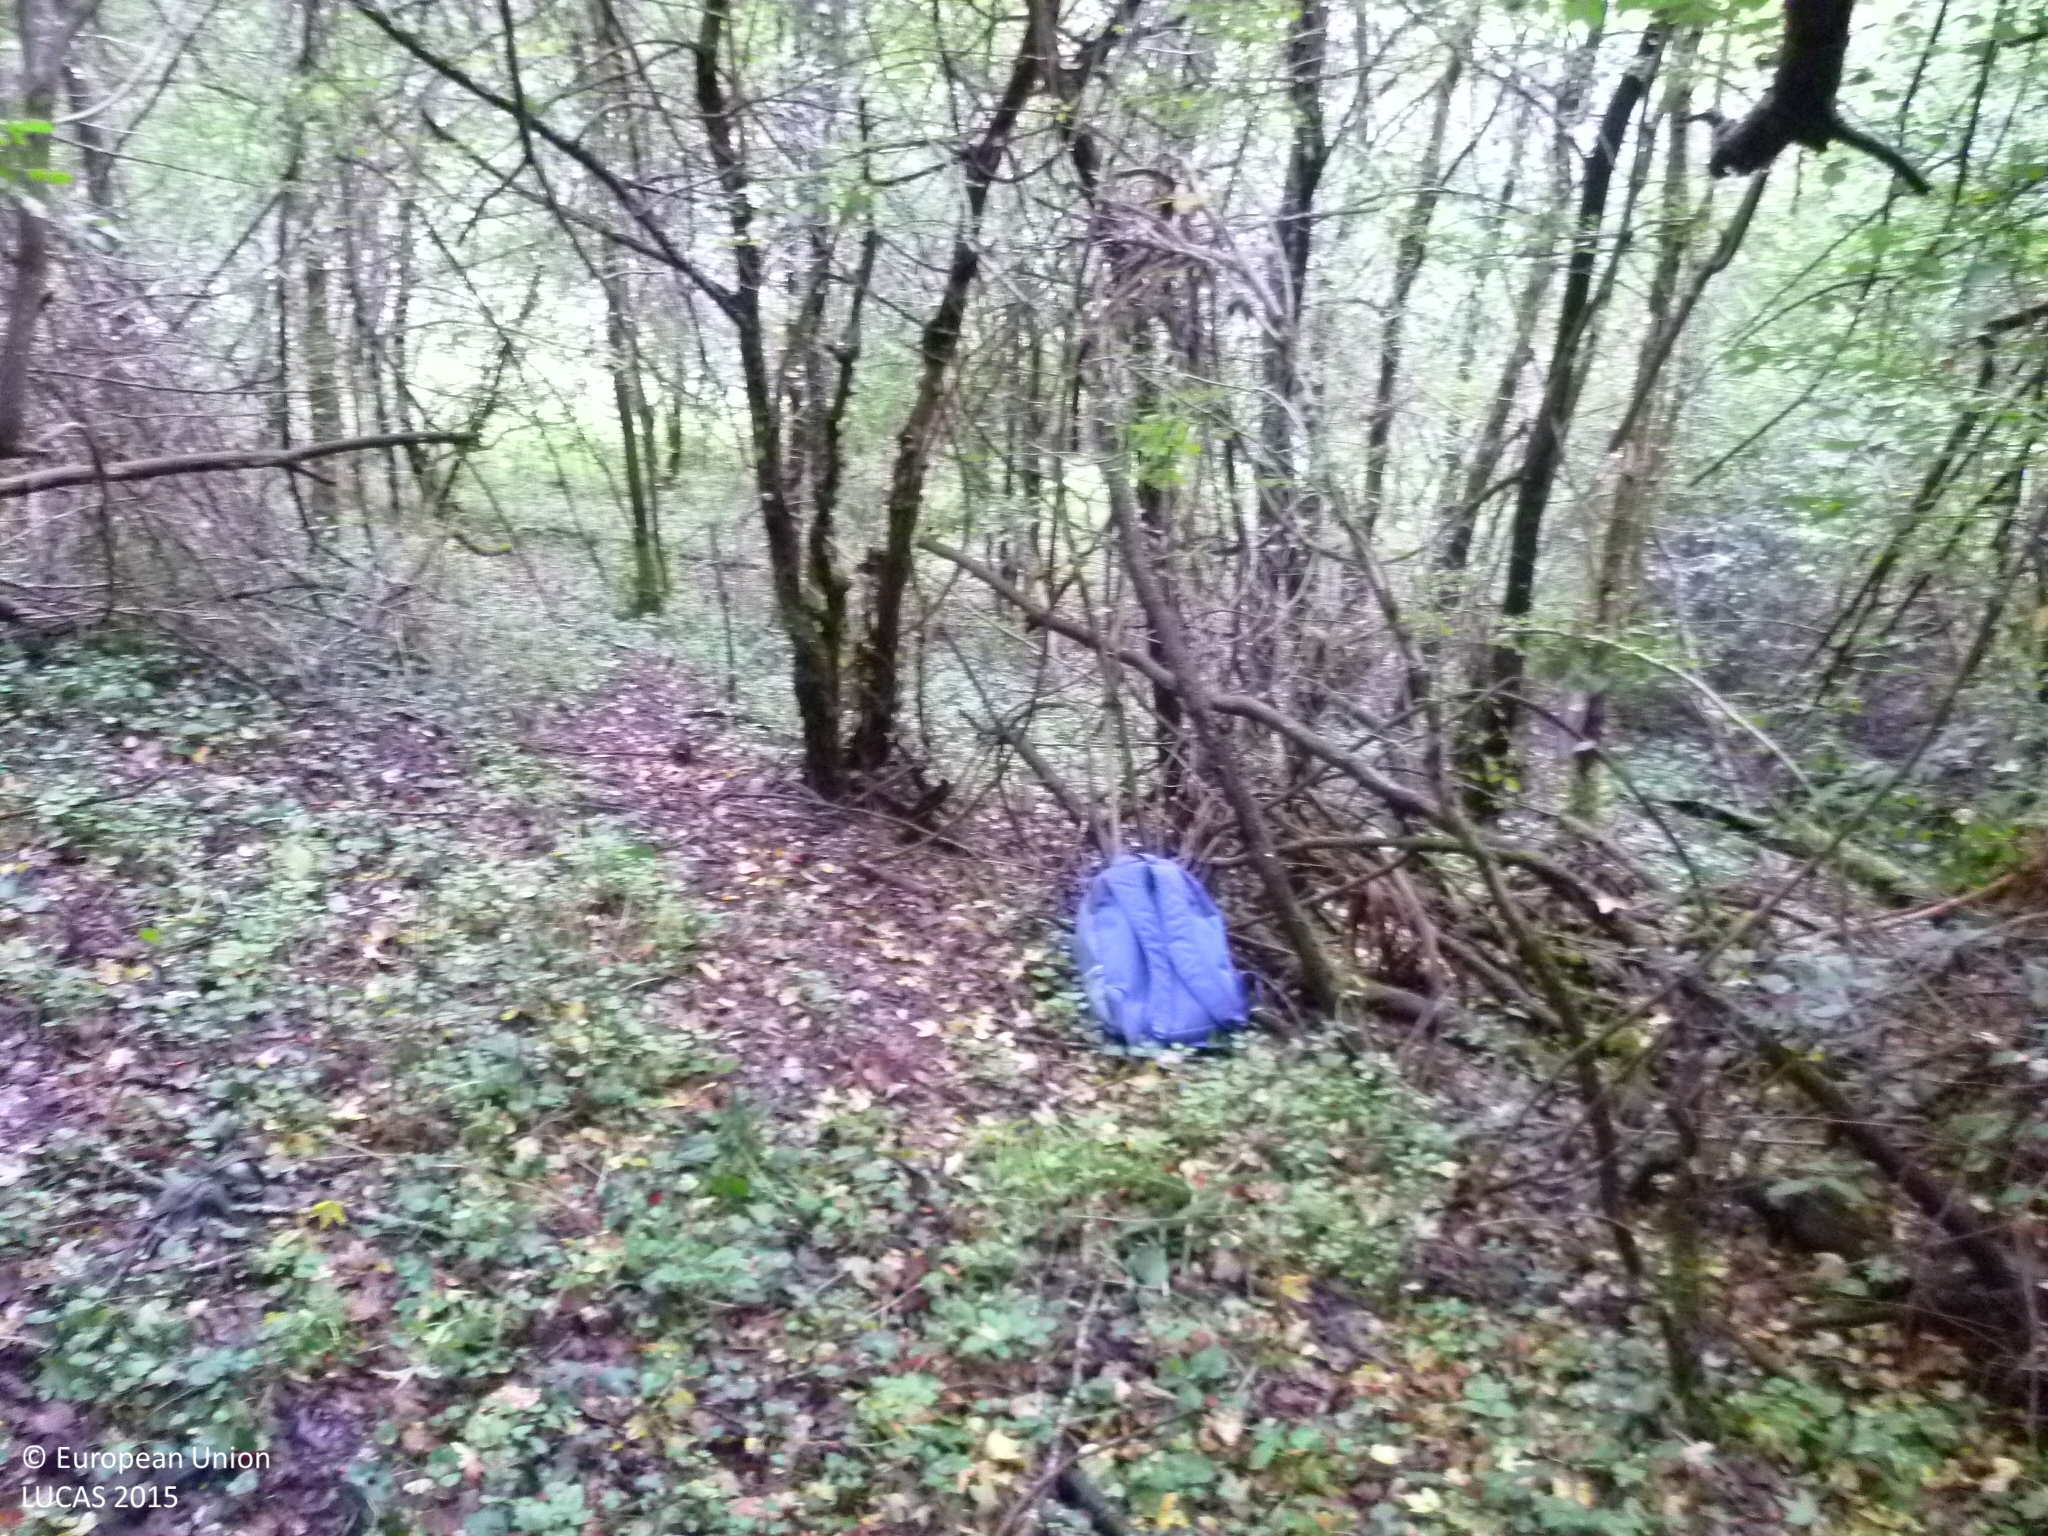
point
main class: Woodland
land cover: Broadleaved woodland
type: mesophytic deciduous forest
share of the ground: > 75 %
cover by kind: broadleaved forest trees 85 %, herbaceous plants 15 %
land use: Forestry
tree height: > 5 m
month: September
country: BG
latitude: 42.5950
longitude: 22.7363
